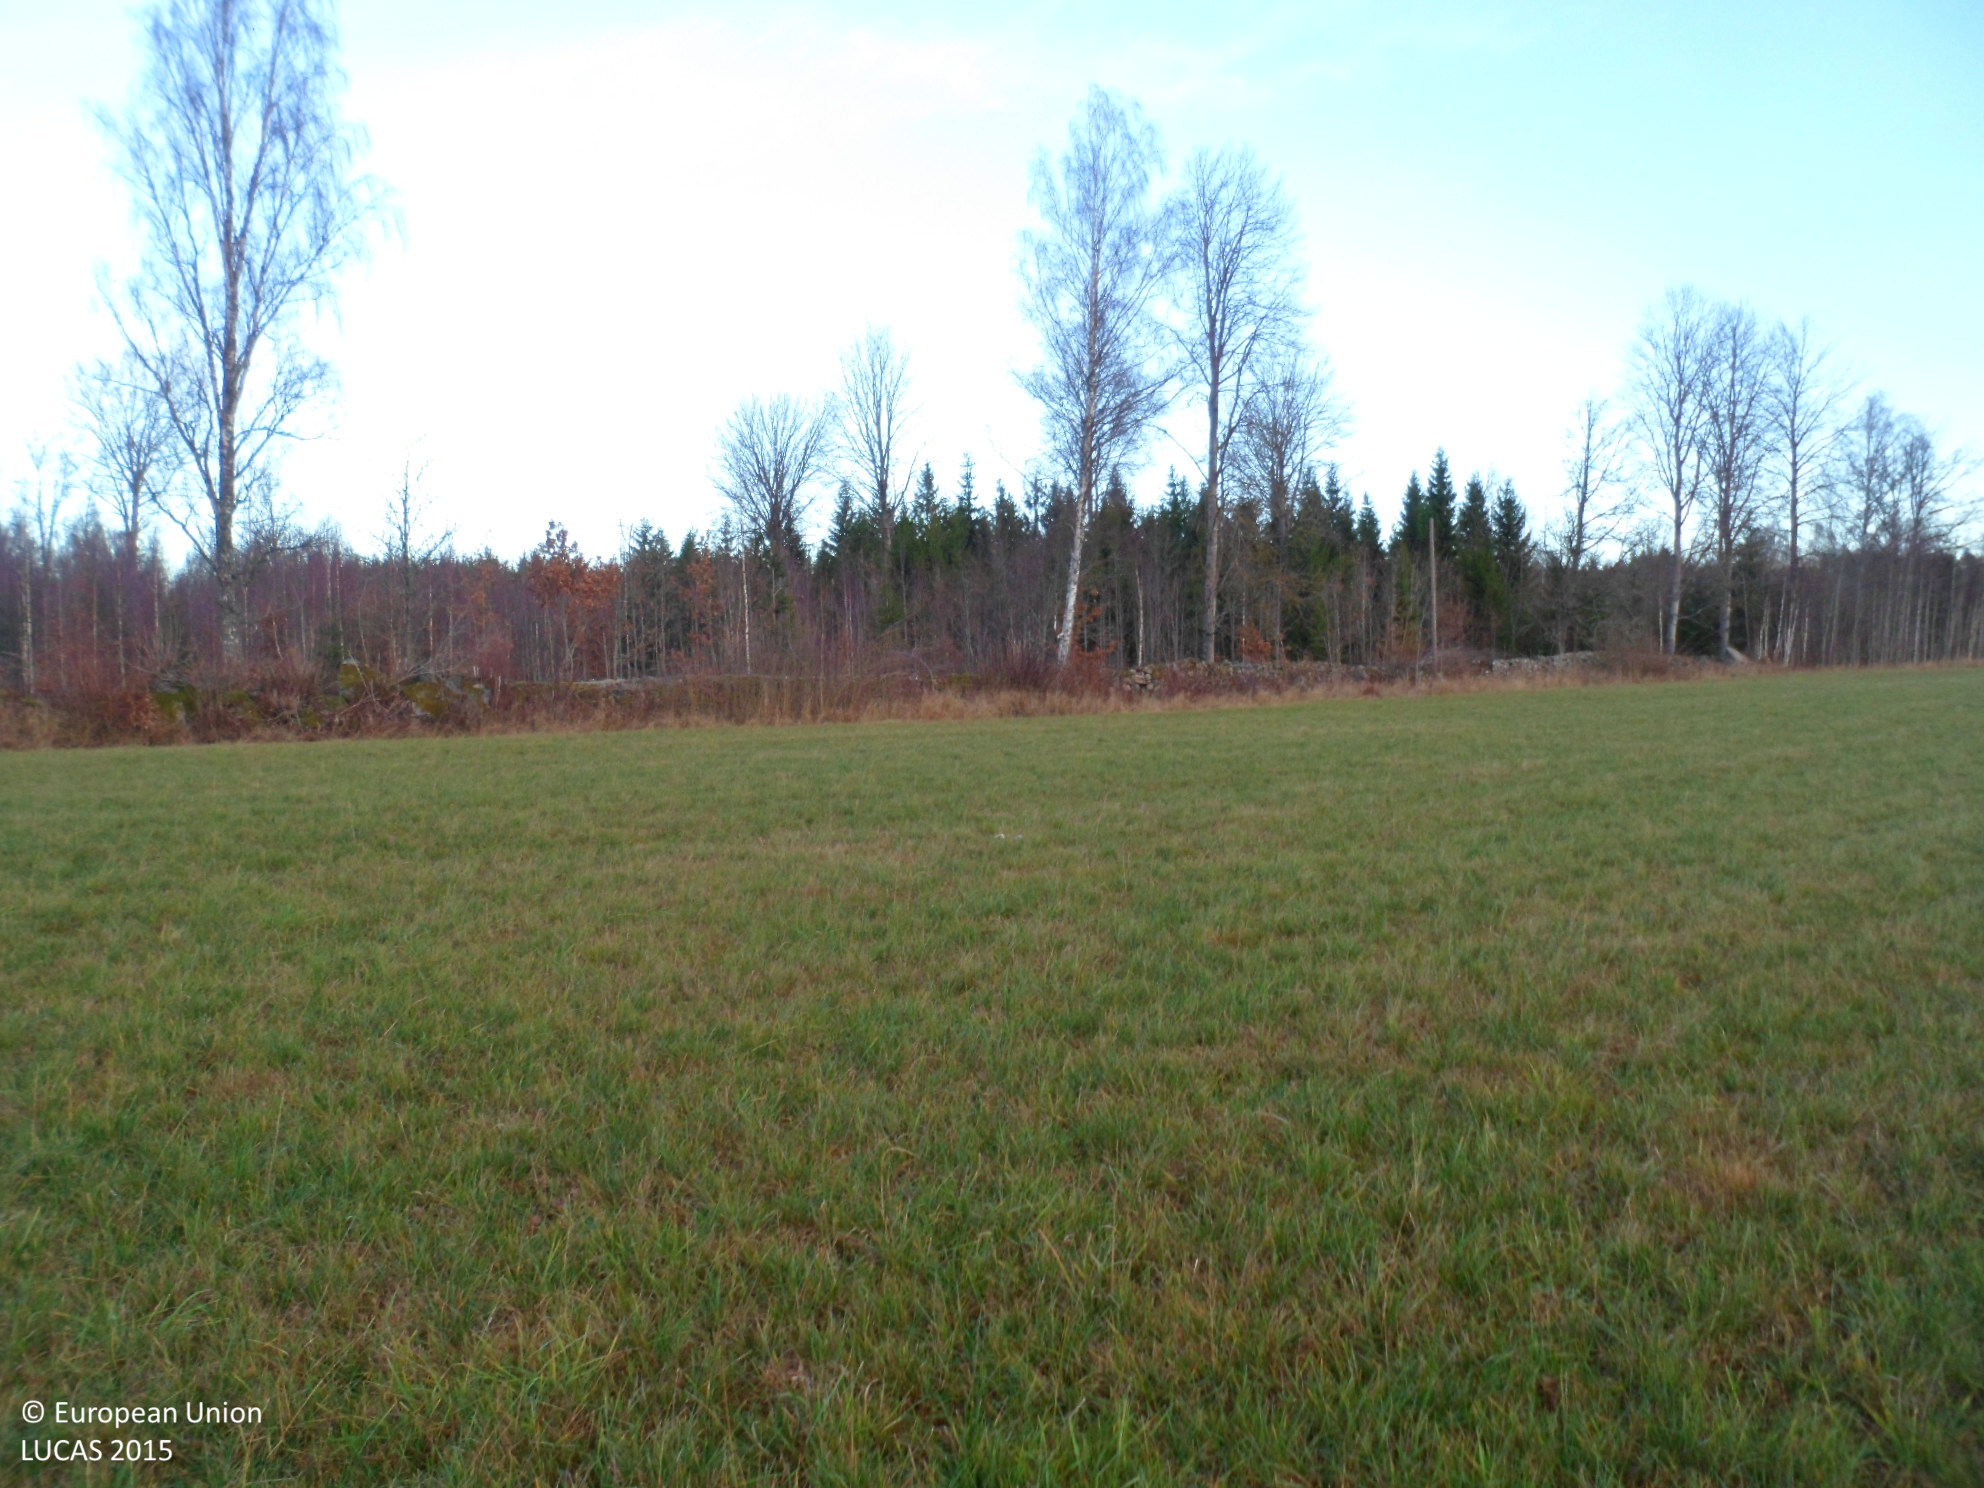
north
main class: Grassland
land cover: Grassland without tree/shrub cover
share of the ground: > 75 %
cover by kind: herbaceous plants 100 %
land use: Agriculture (excluding fallow land and kitchen gardens)
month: November
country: SE
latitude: 56.9536
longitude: 15.9017
